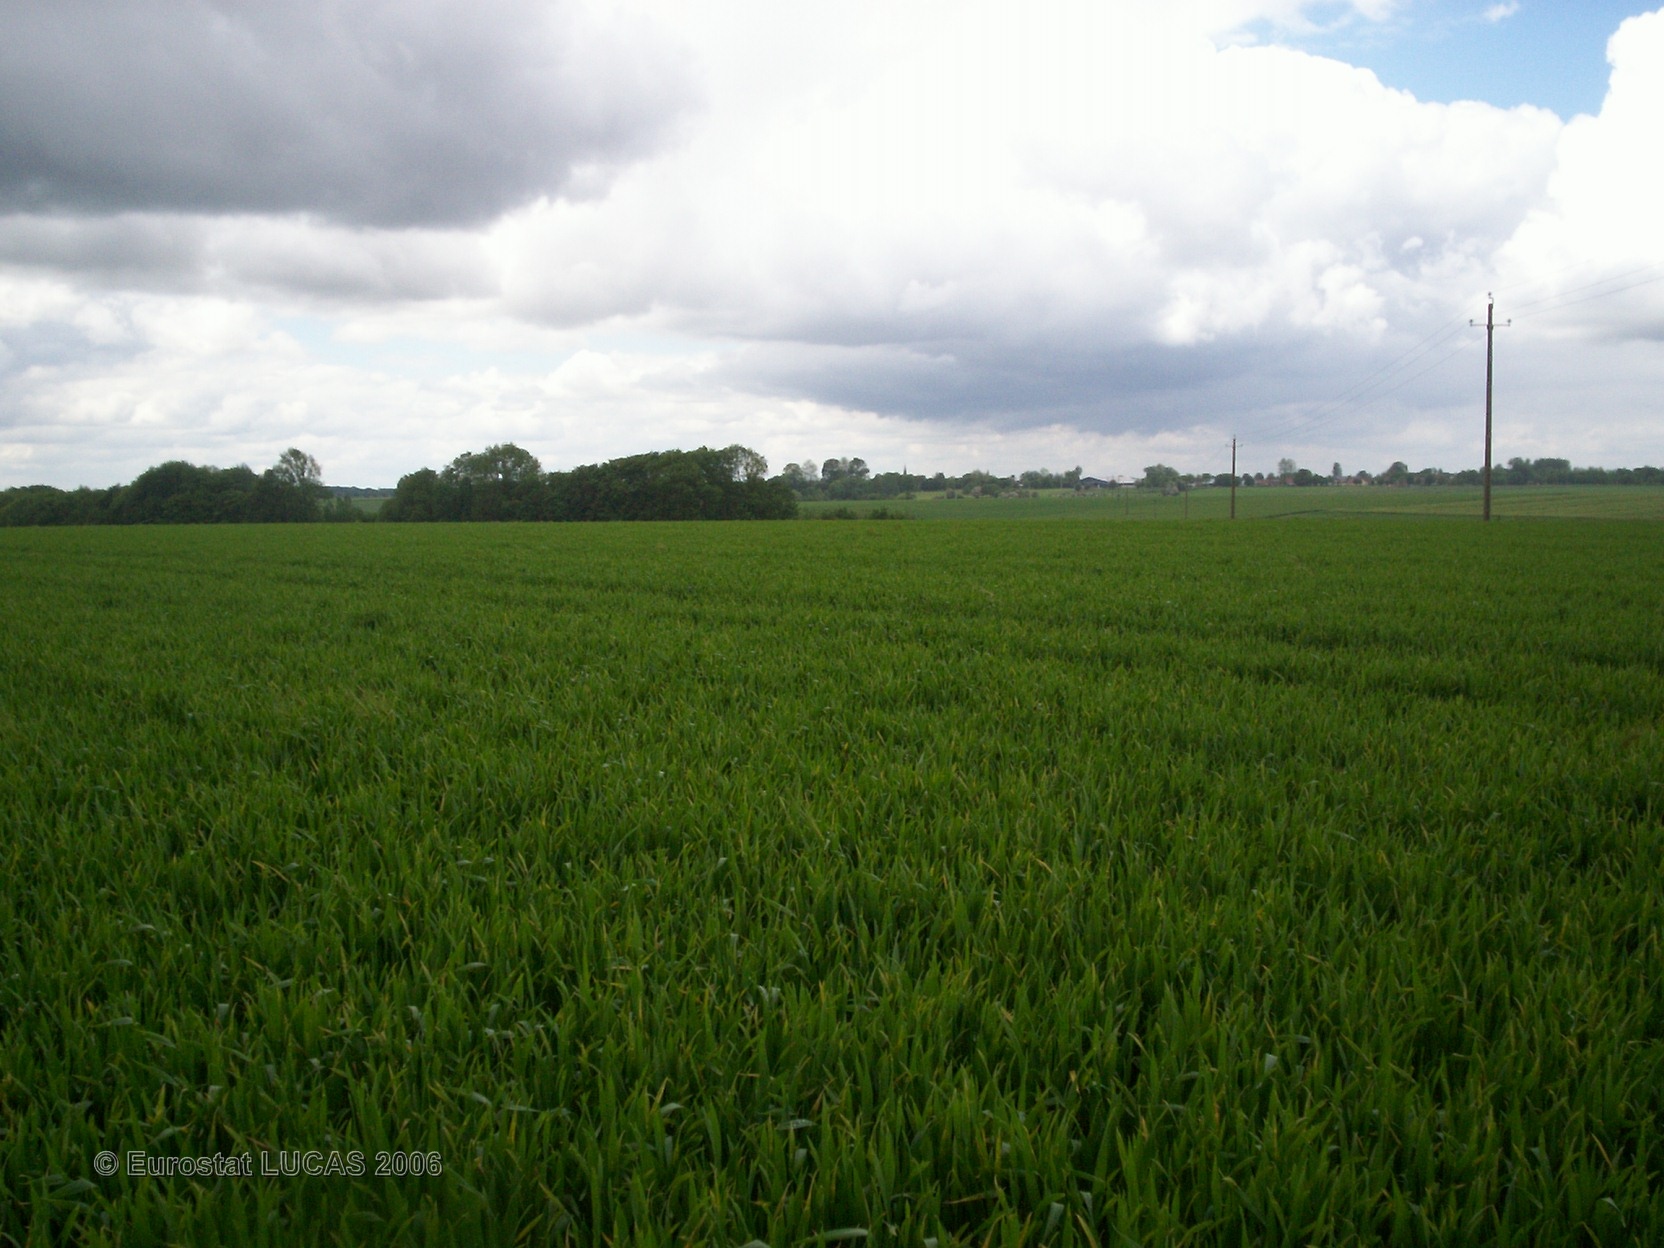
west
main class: Cropland
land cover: Common wheat
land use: Agriculture (excluding fallow land and kitchen gardens)
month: May
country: FR
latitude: 50.1753
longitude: 2.5526
